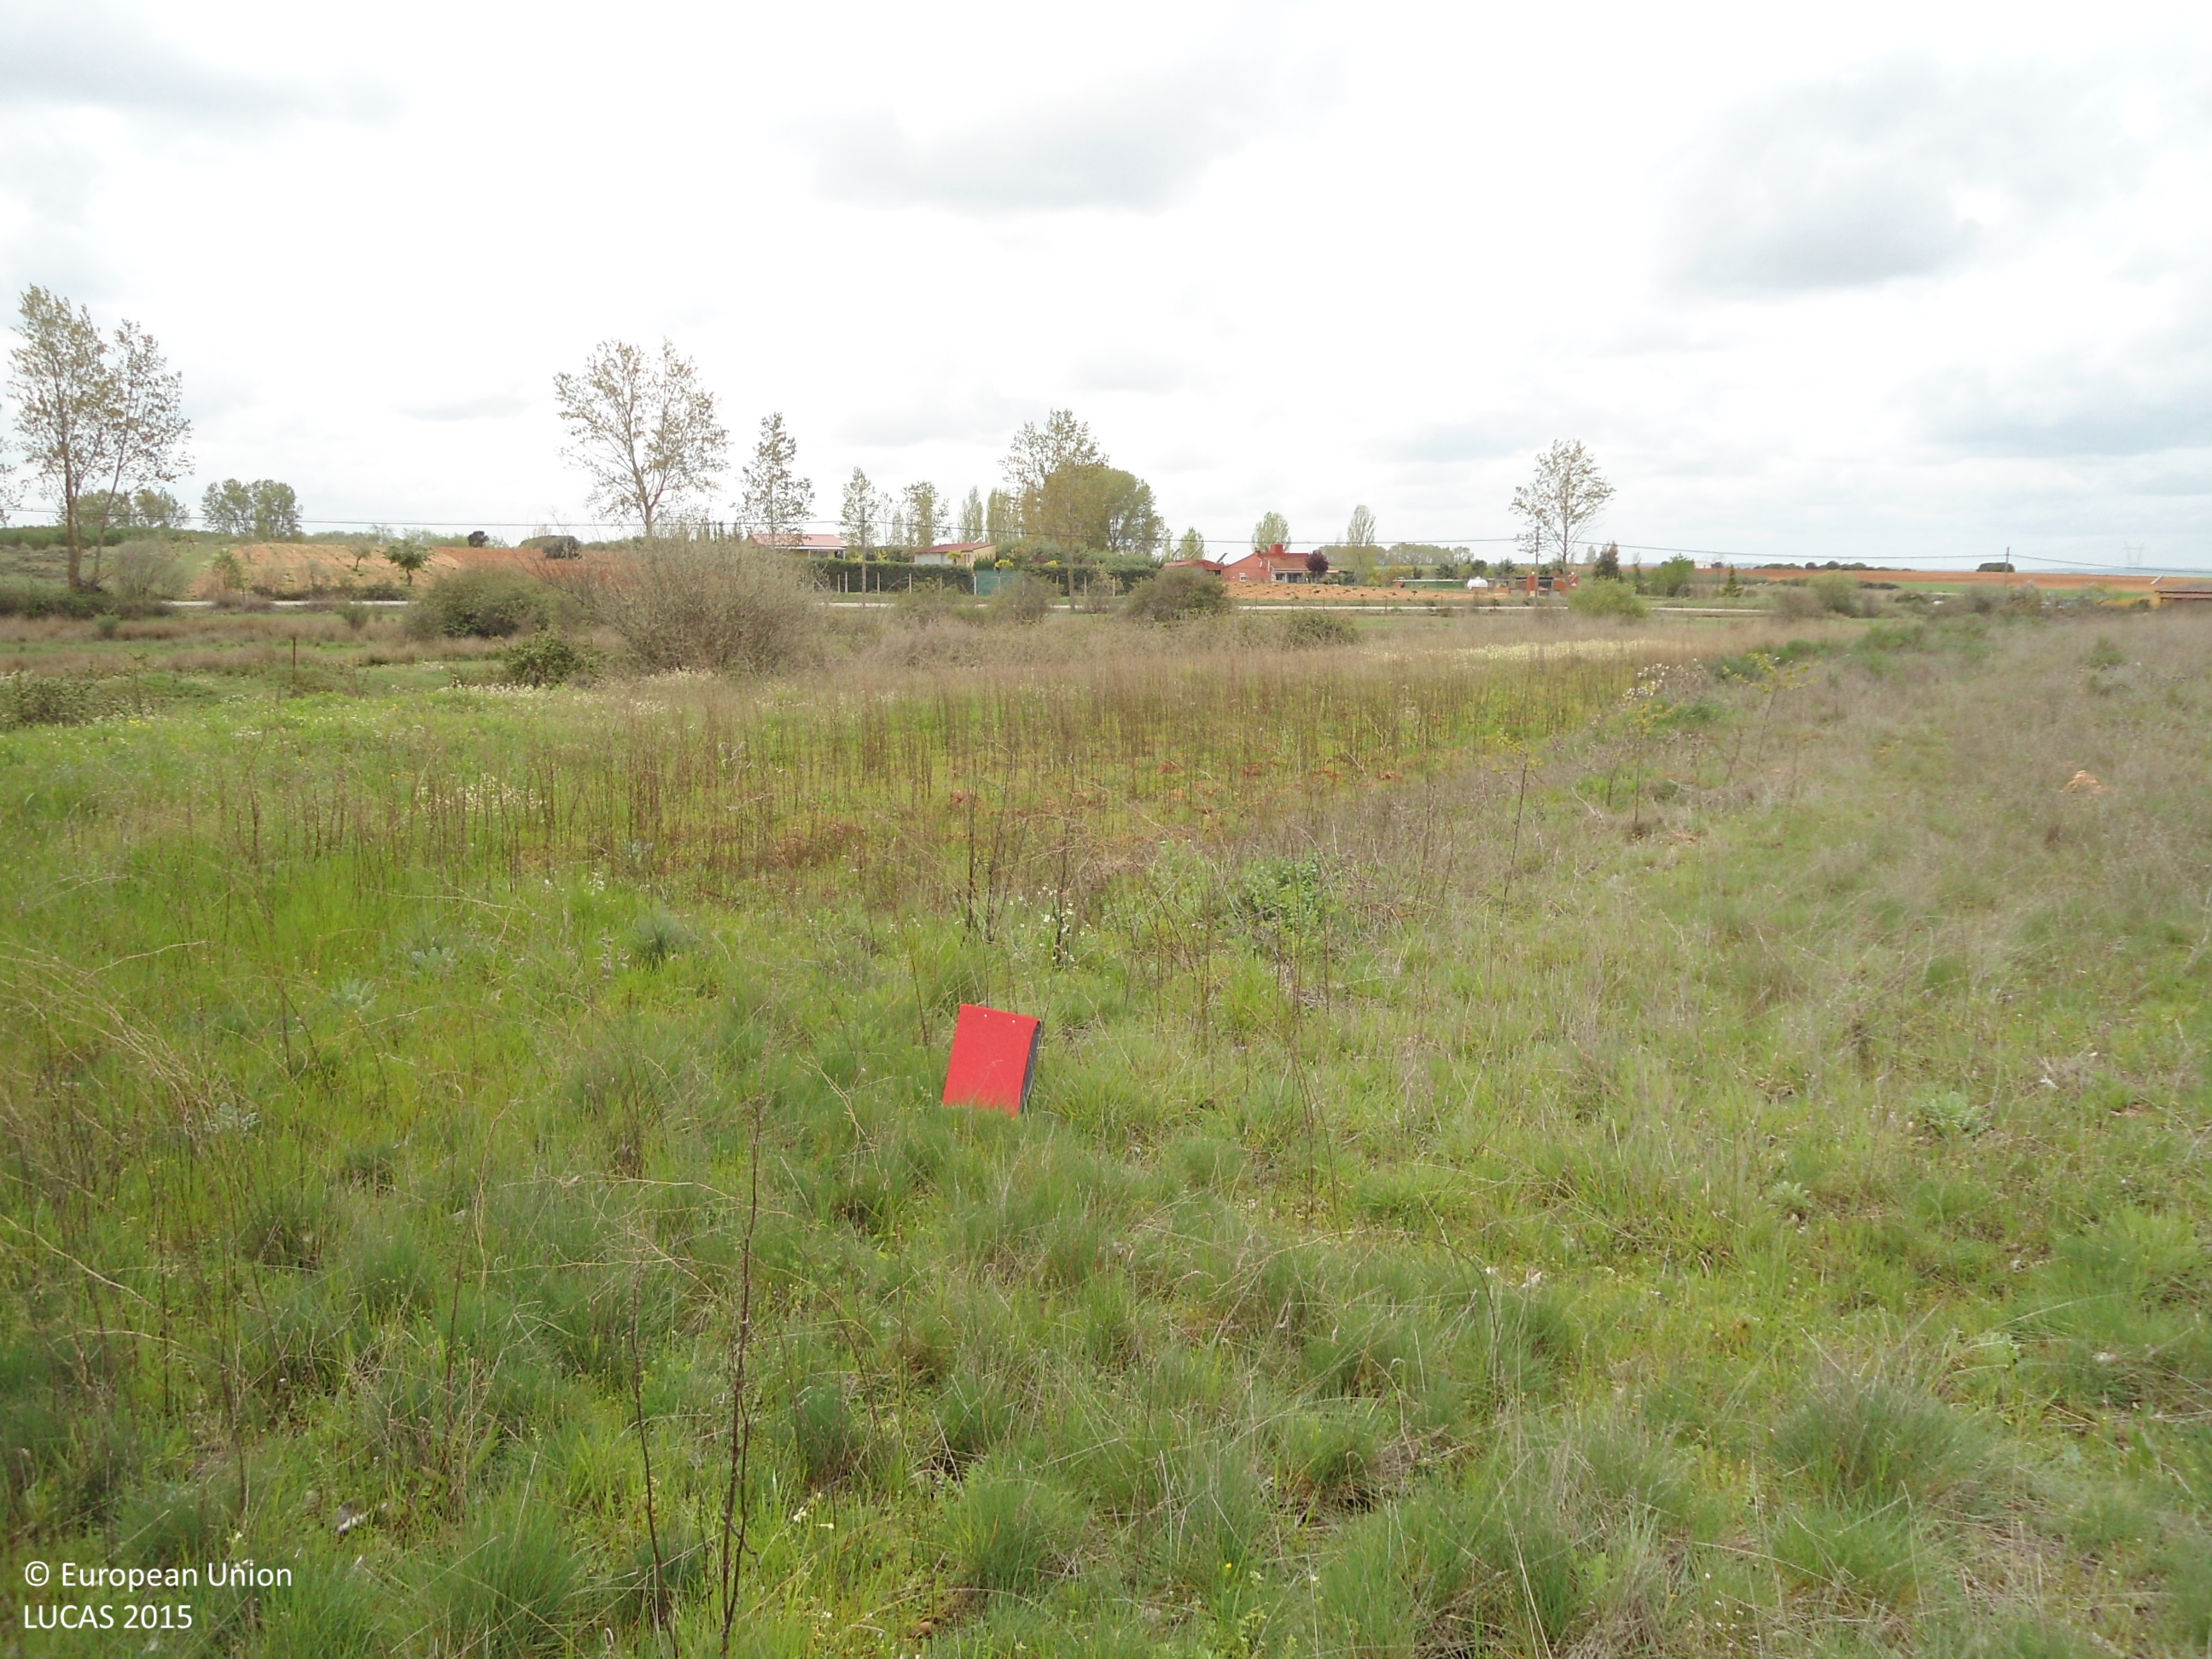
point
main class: Grassland
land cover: Spontaneously vegetated surfaces
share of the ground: > 75 %
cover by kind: herbaceous plants 95 %, shrubs 5 %
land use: Fallow land
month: April
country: ES
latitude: 41.5823
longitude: -5.8385
